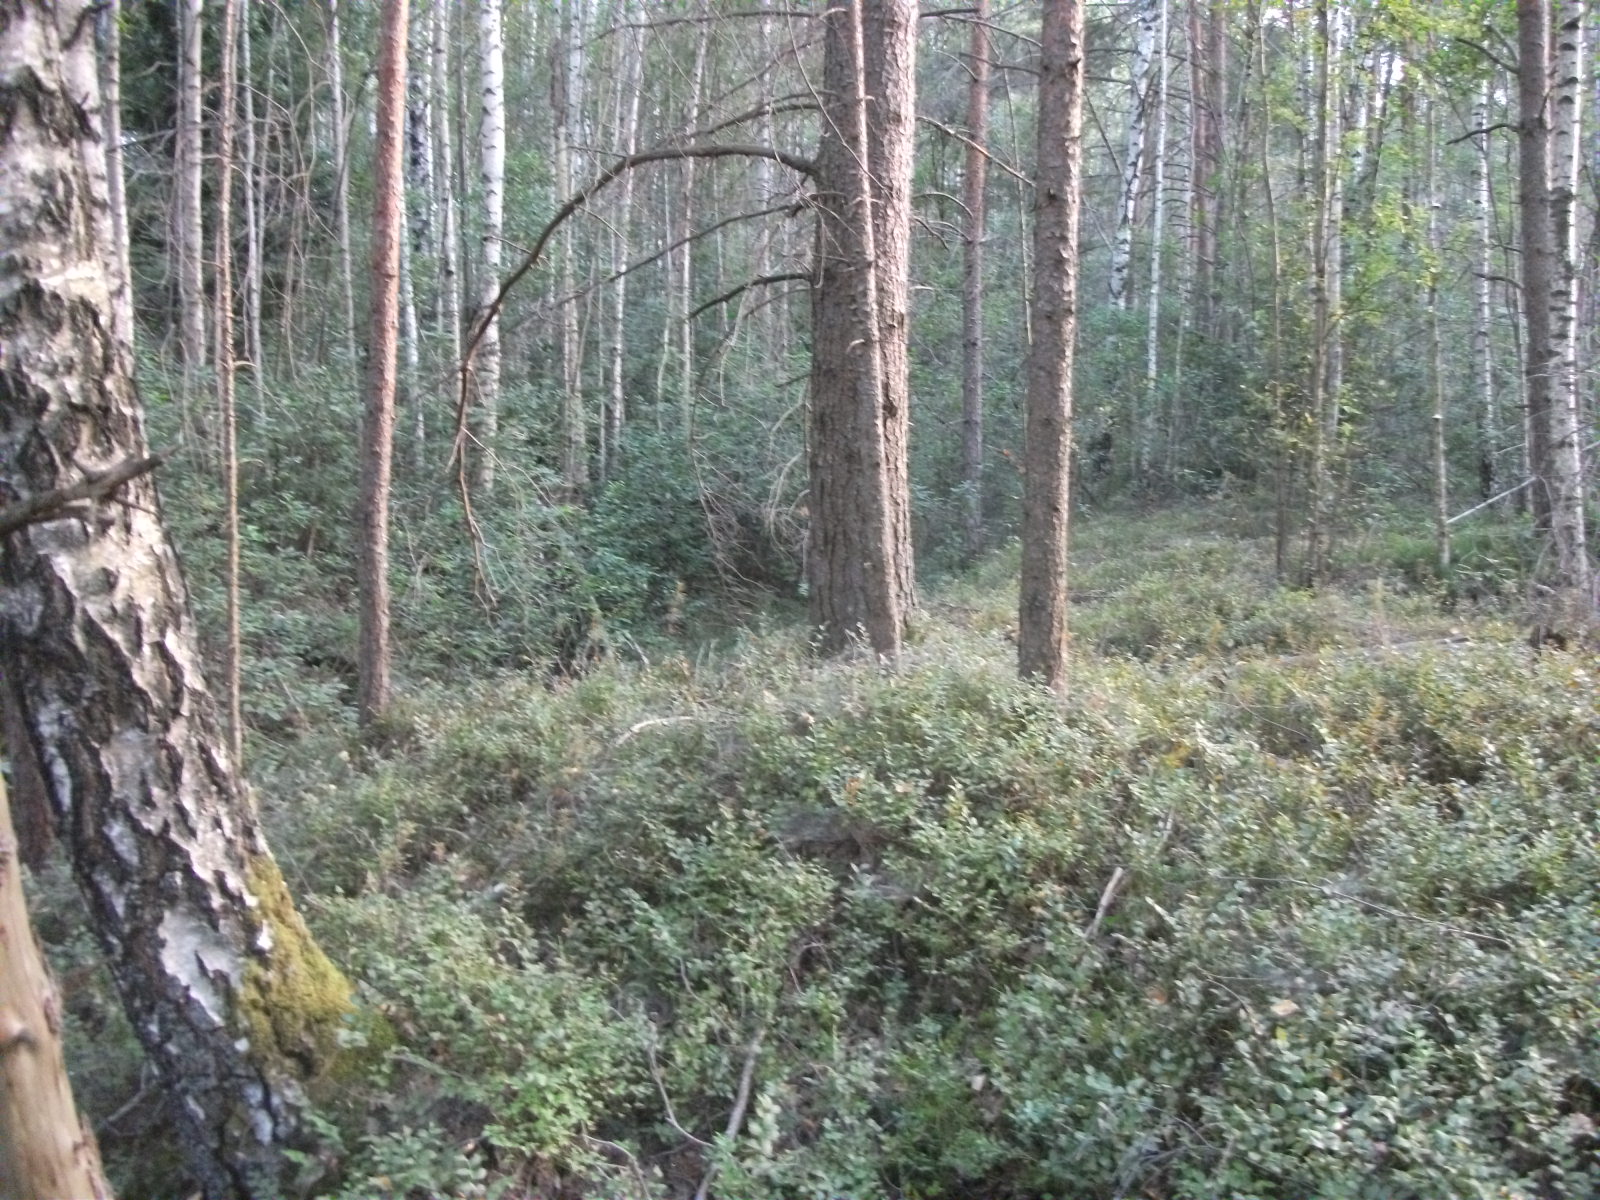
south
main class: Woodland
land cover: Pine dominated mixed woodland
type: hemiboreal forest and nemoral coniferous forest and mixed broadleaved-coniferous forest
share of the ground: > 75 %
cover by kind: coniferous forest trees 50 %, broadleaved forest trees 30 %, herbaceous plants 10 %, lichens and mosses 10 %
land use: Forestry
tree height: > 5 m
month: August
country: LV
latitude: 56.3653
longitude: 26.3148
